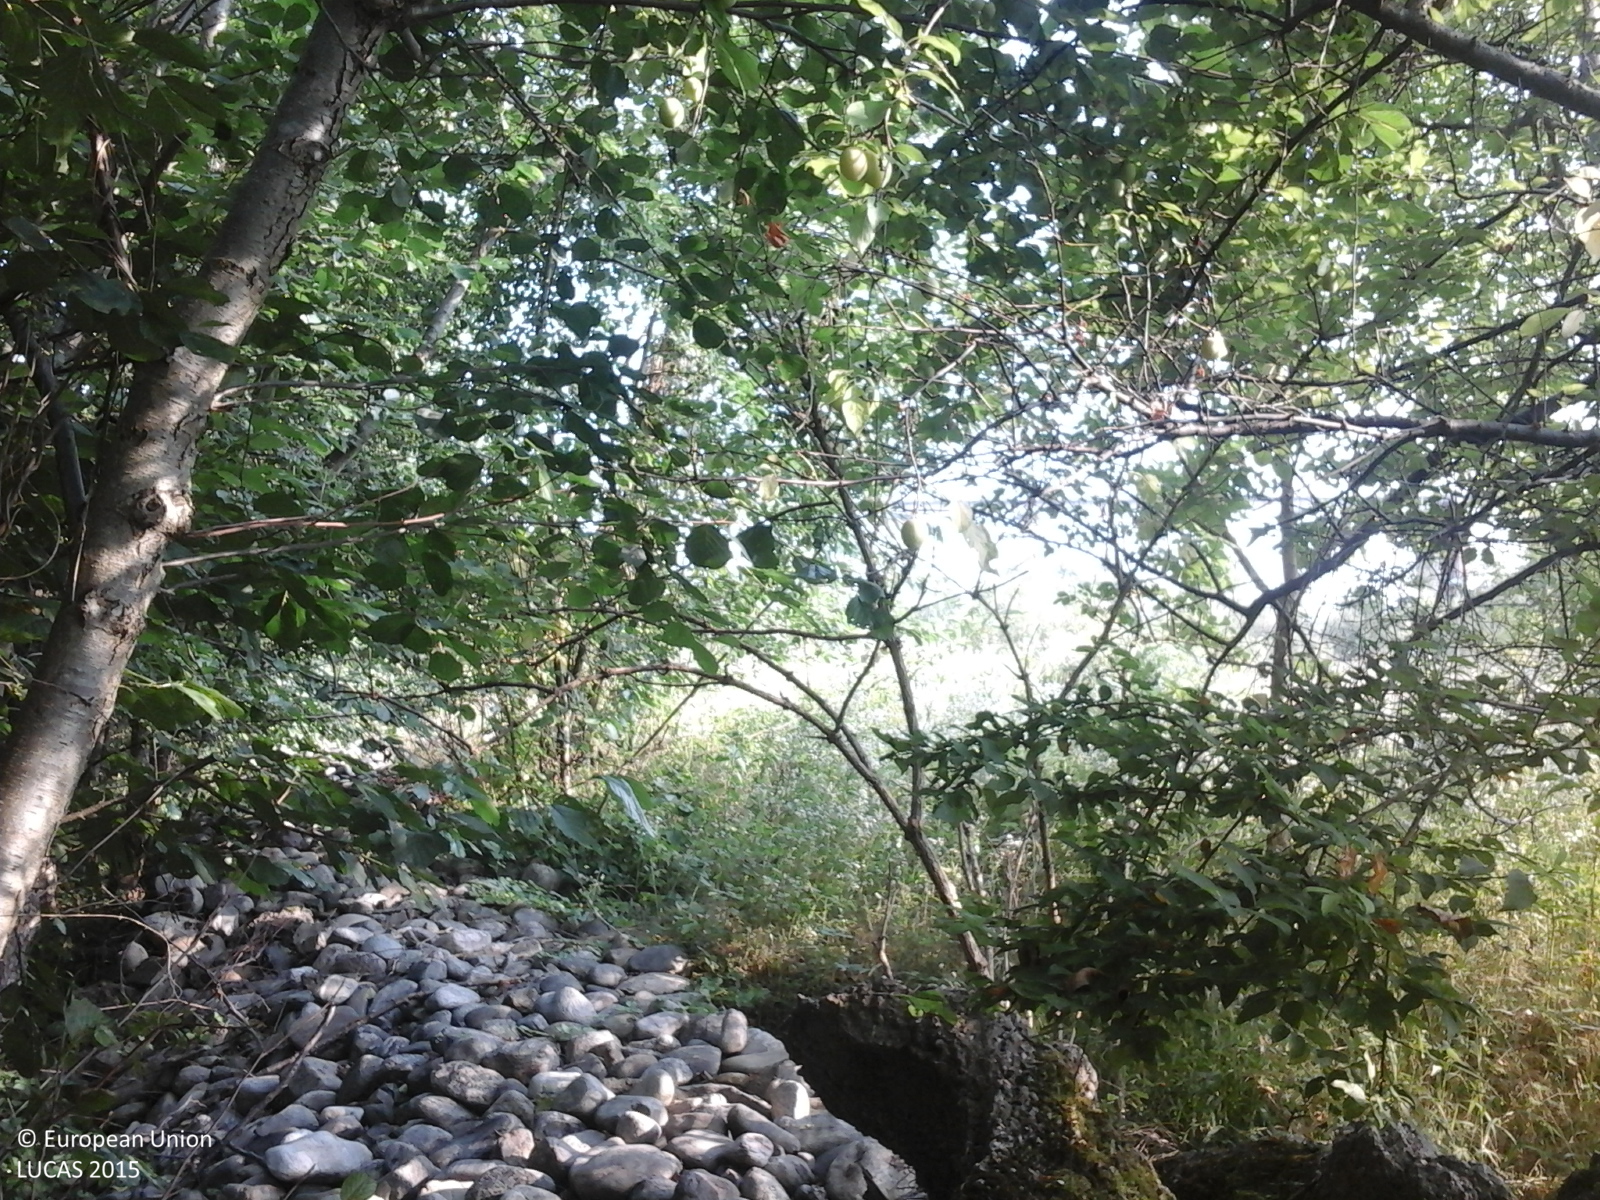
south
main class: Woodland
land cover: Broadleaved woodland
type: beech forest
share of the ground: > 75 %
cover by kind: broadleaved forest trees 100 %
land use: Forestry
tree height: > 5 m
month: July
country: RO
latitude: 45.0937
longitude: 24.5500
